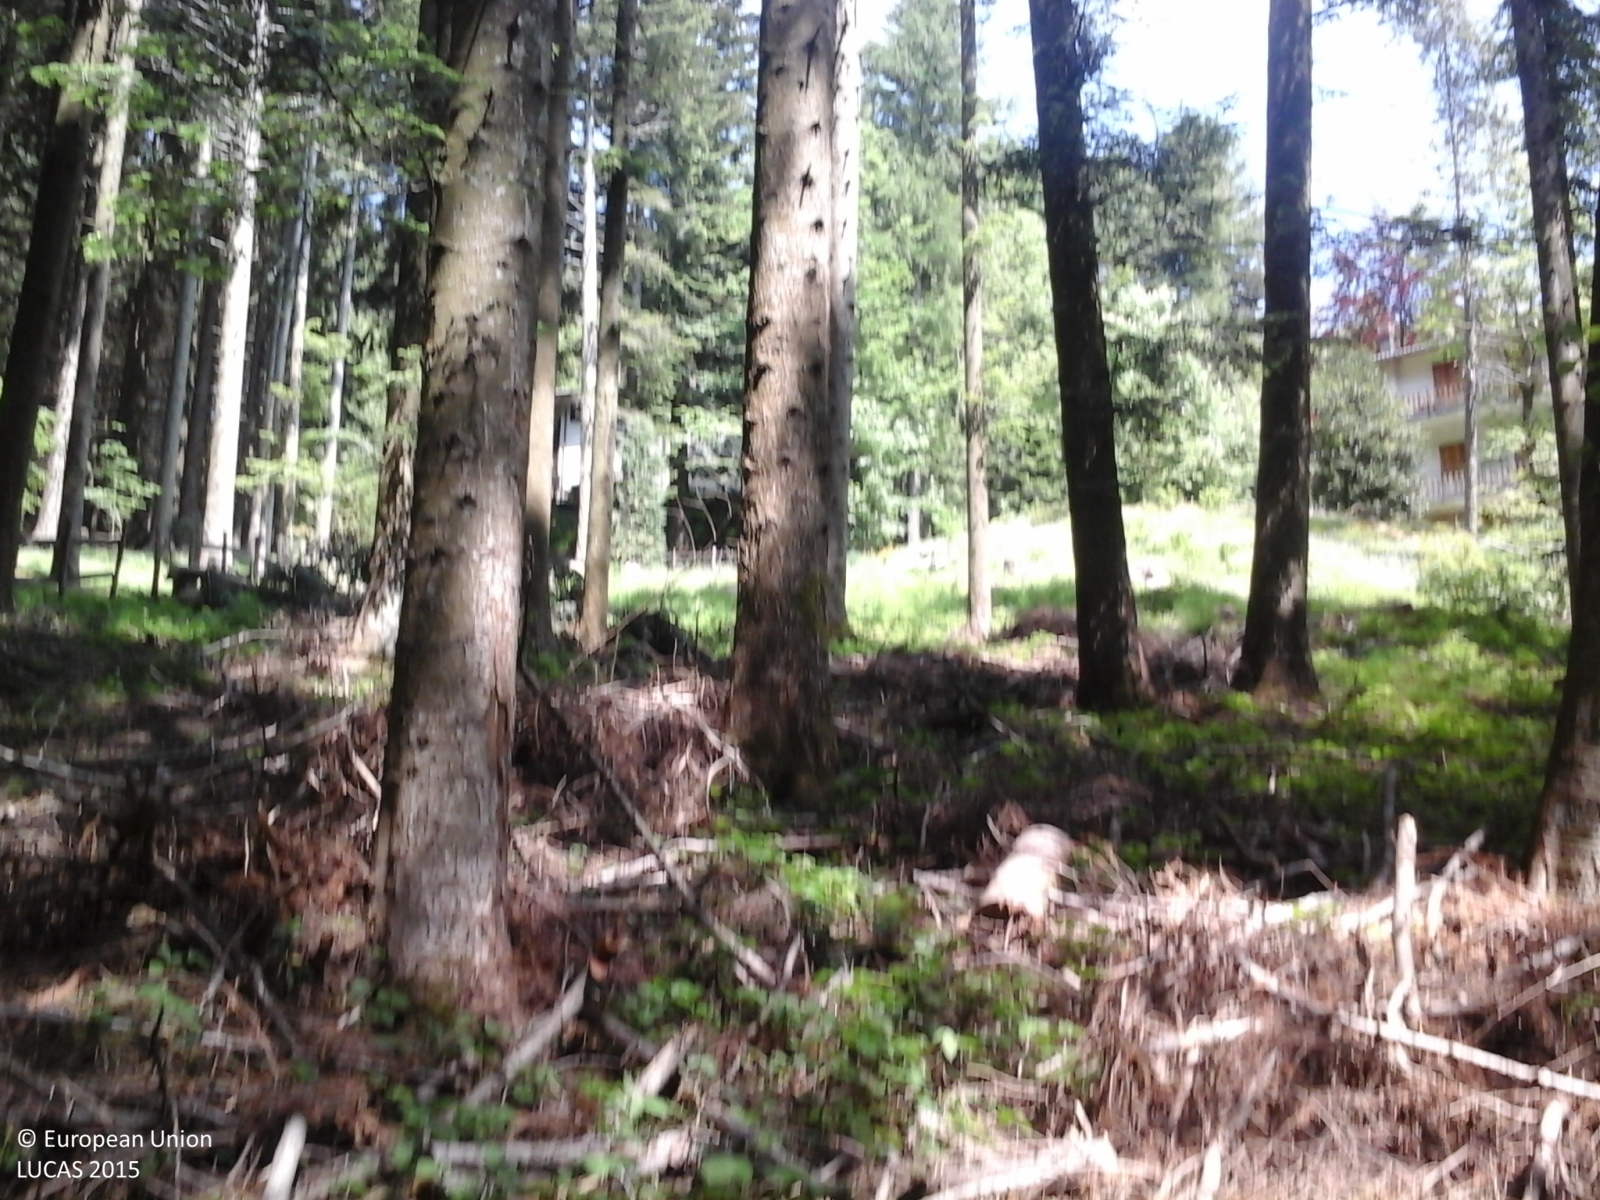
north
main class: Woodland
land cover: Spruce dominated coniferous woodland
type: alpine coniferous forest
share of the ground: > 75 %
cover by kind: coniferous forest trees 100 %
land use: Forestry
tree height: > 5 m
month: May
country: IT
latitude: 44.1093
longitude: 11.1840
